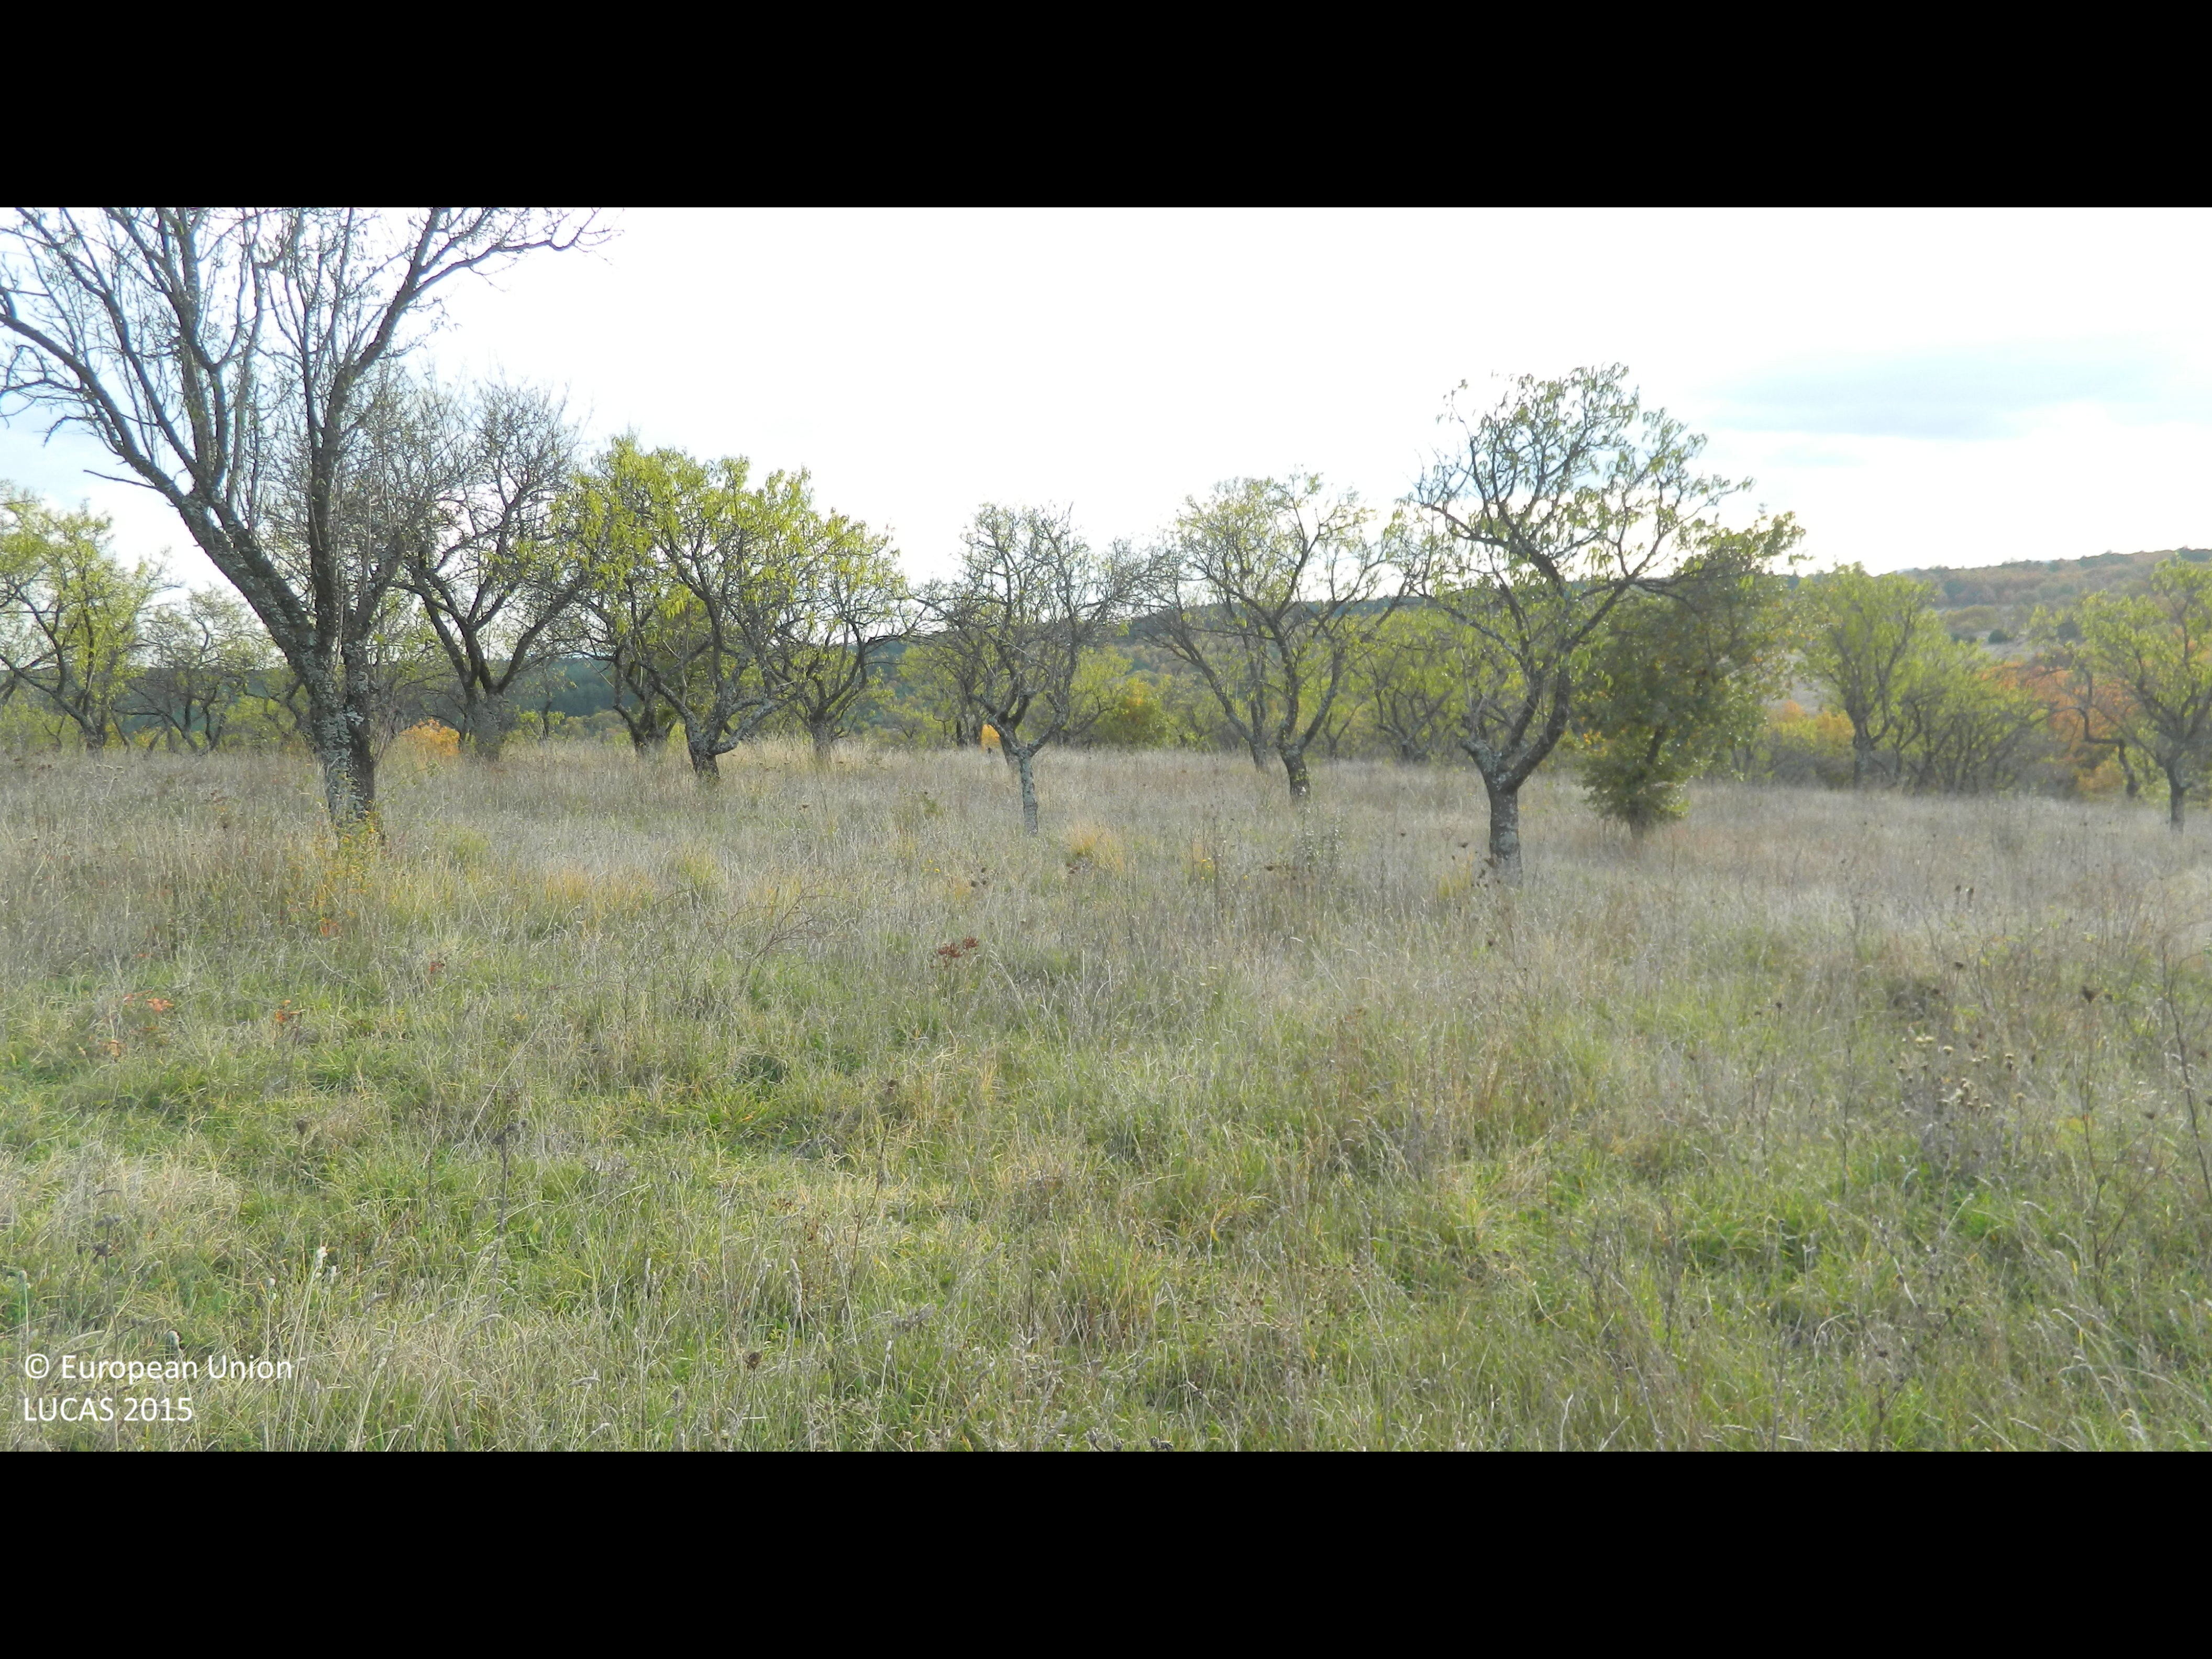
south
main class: Cropland
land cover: Nuts trees
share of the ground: 25 - 50 %
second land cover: Grassland without tree/shrub cover
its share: > 75 %
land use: Agriculture (excluding fallow land and kitchen gardens)
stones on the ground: < 10 %
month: November
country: BG
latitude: 41.4562
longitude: 26.0500
